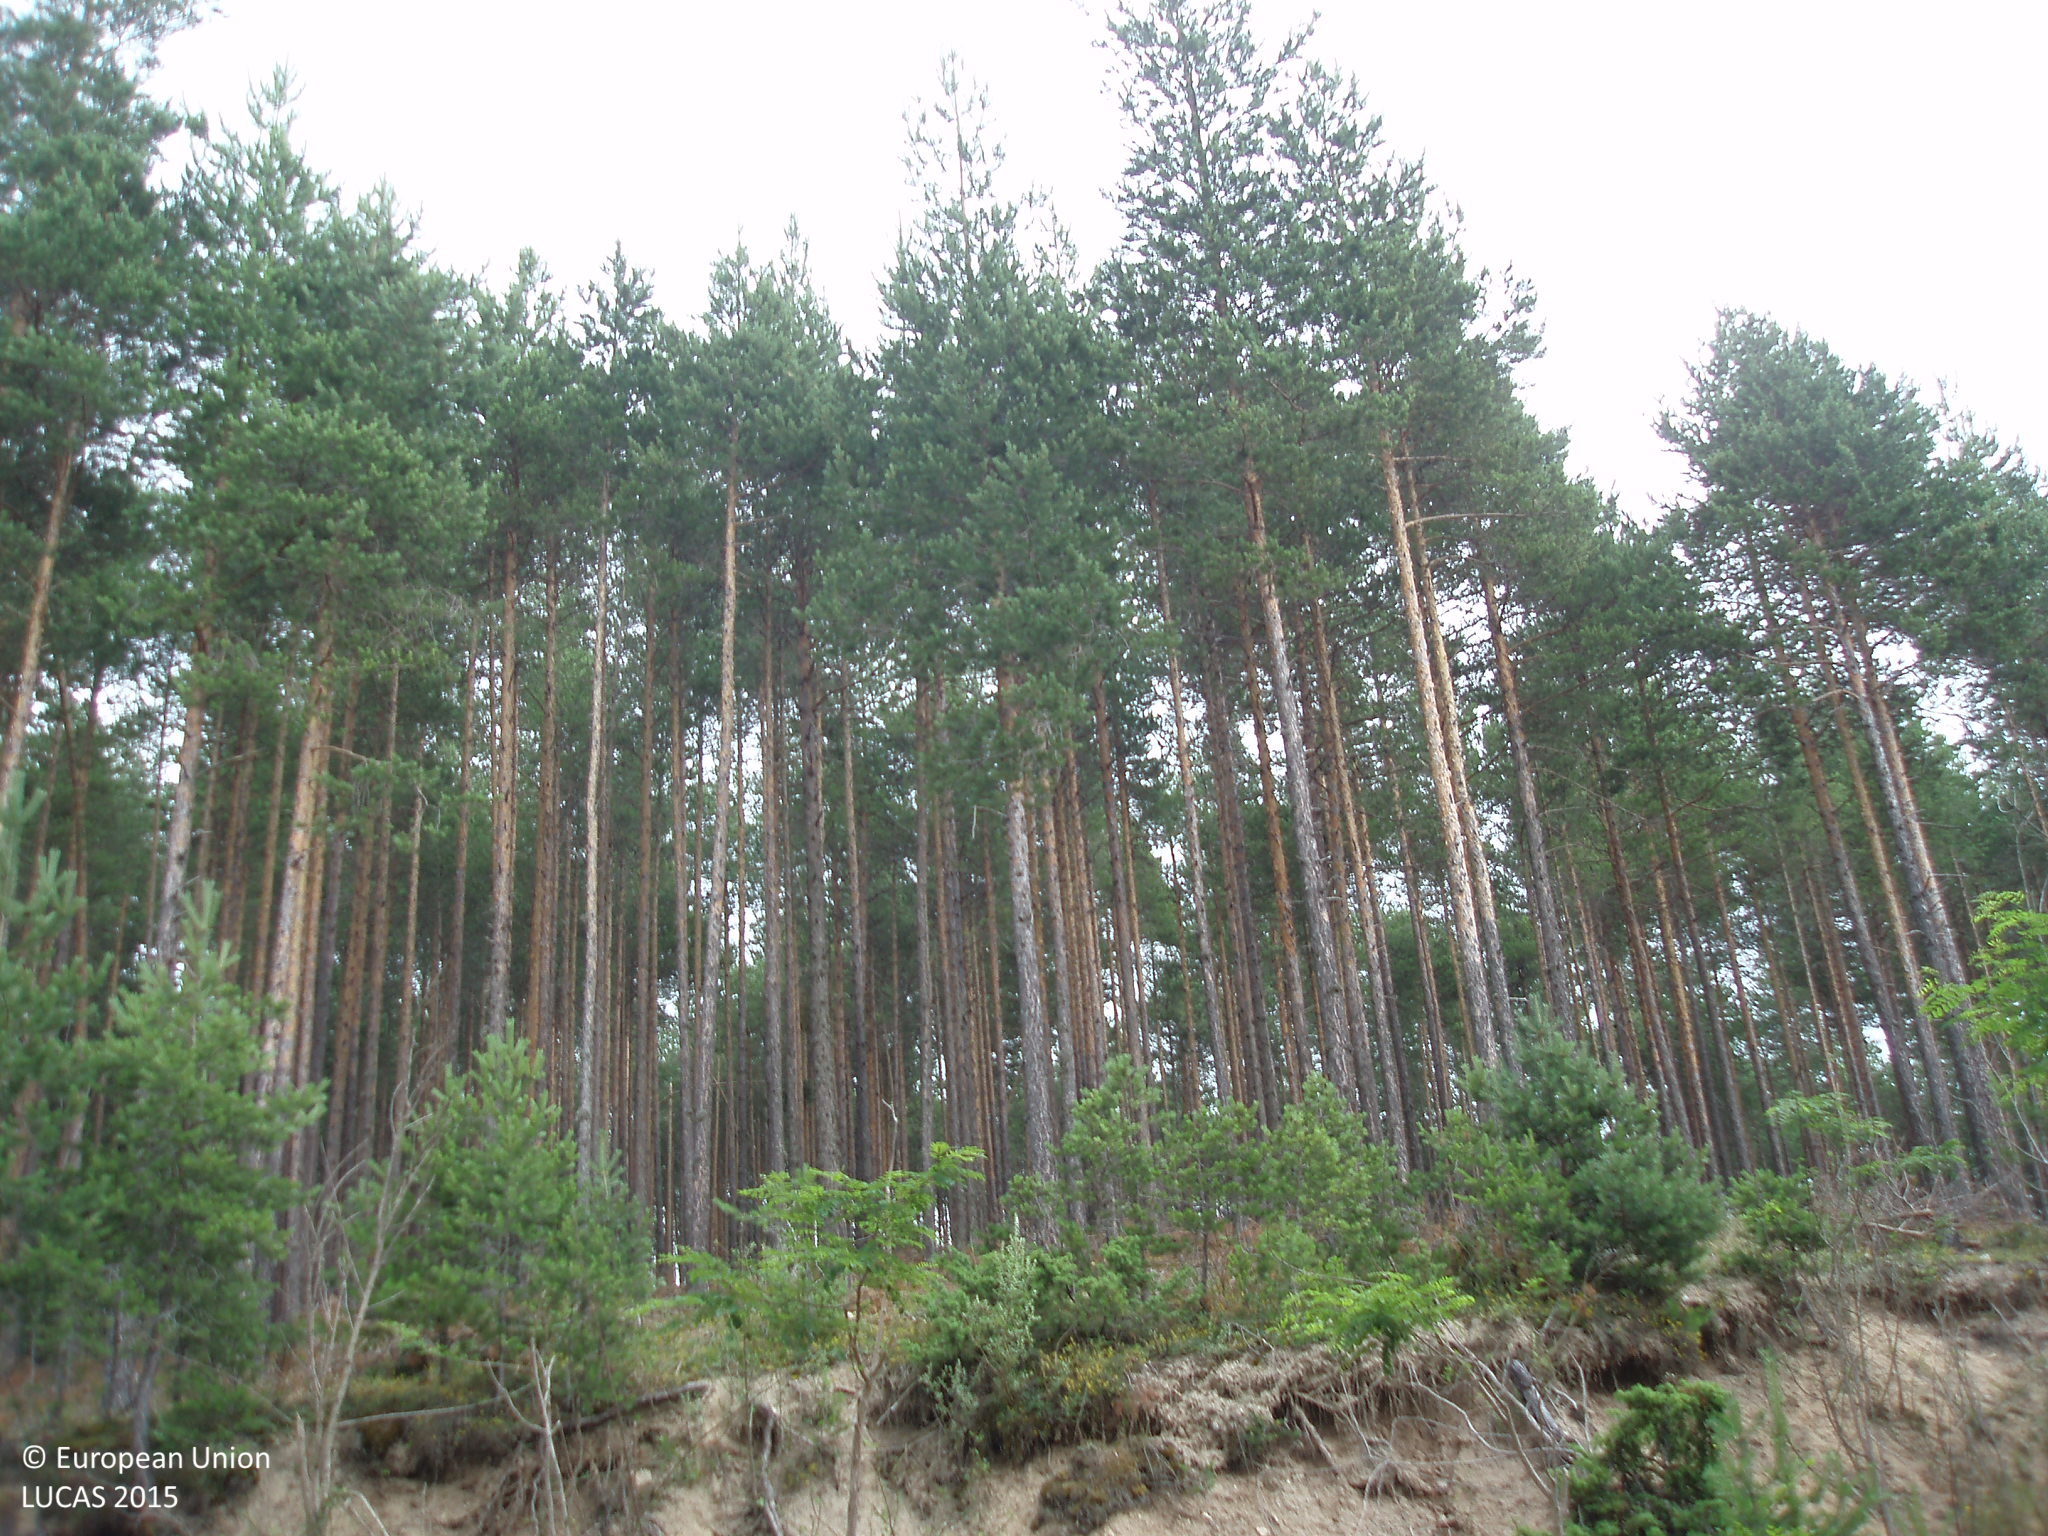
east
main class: Woodland
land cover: Pine dominated coniferous woodland
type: hemiboreal forest and nemoral coniferous forest and mixed broadleaved-coniferous forest
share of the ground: > 75 %
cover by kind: coniferous forest trees 100 %
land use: Forestry
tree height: > 5 m
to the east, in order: Pine dominated coniferous woodland; Grassland without tree/shrub cover
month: July
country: BG
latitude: 42.0268
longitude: 23.7173
